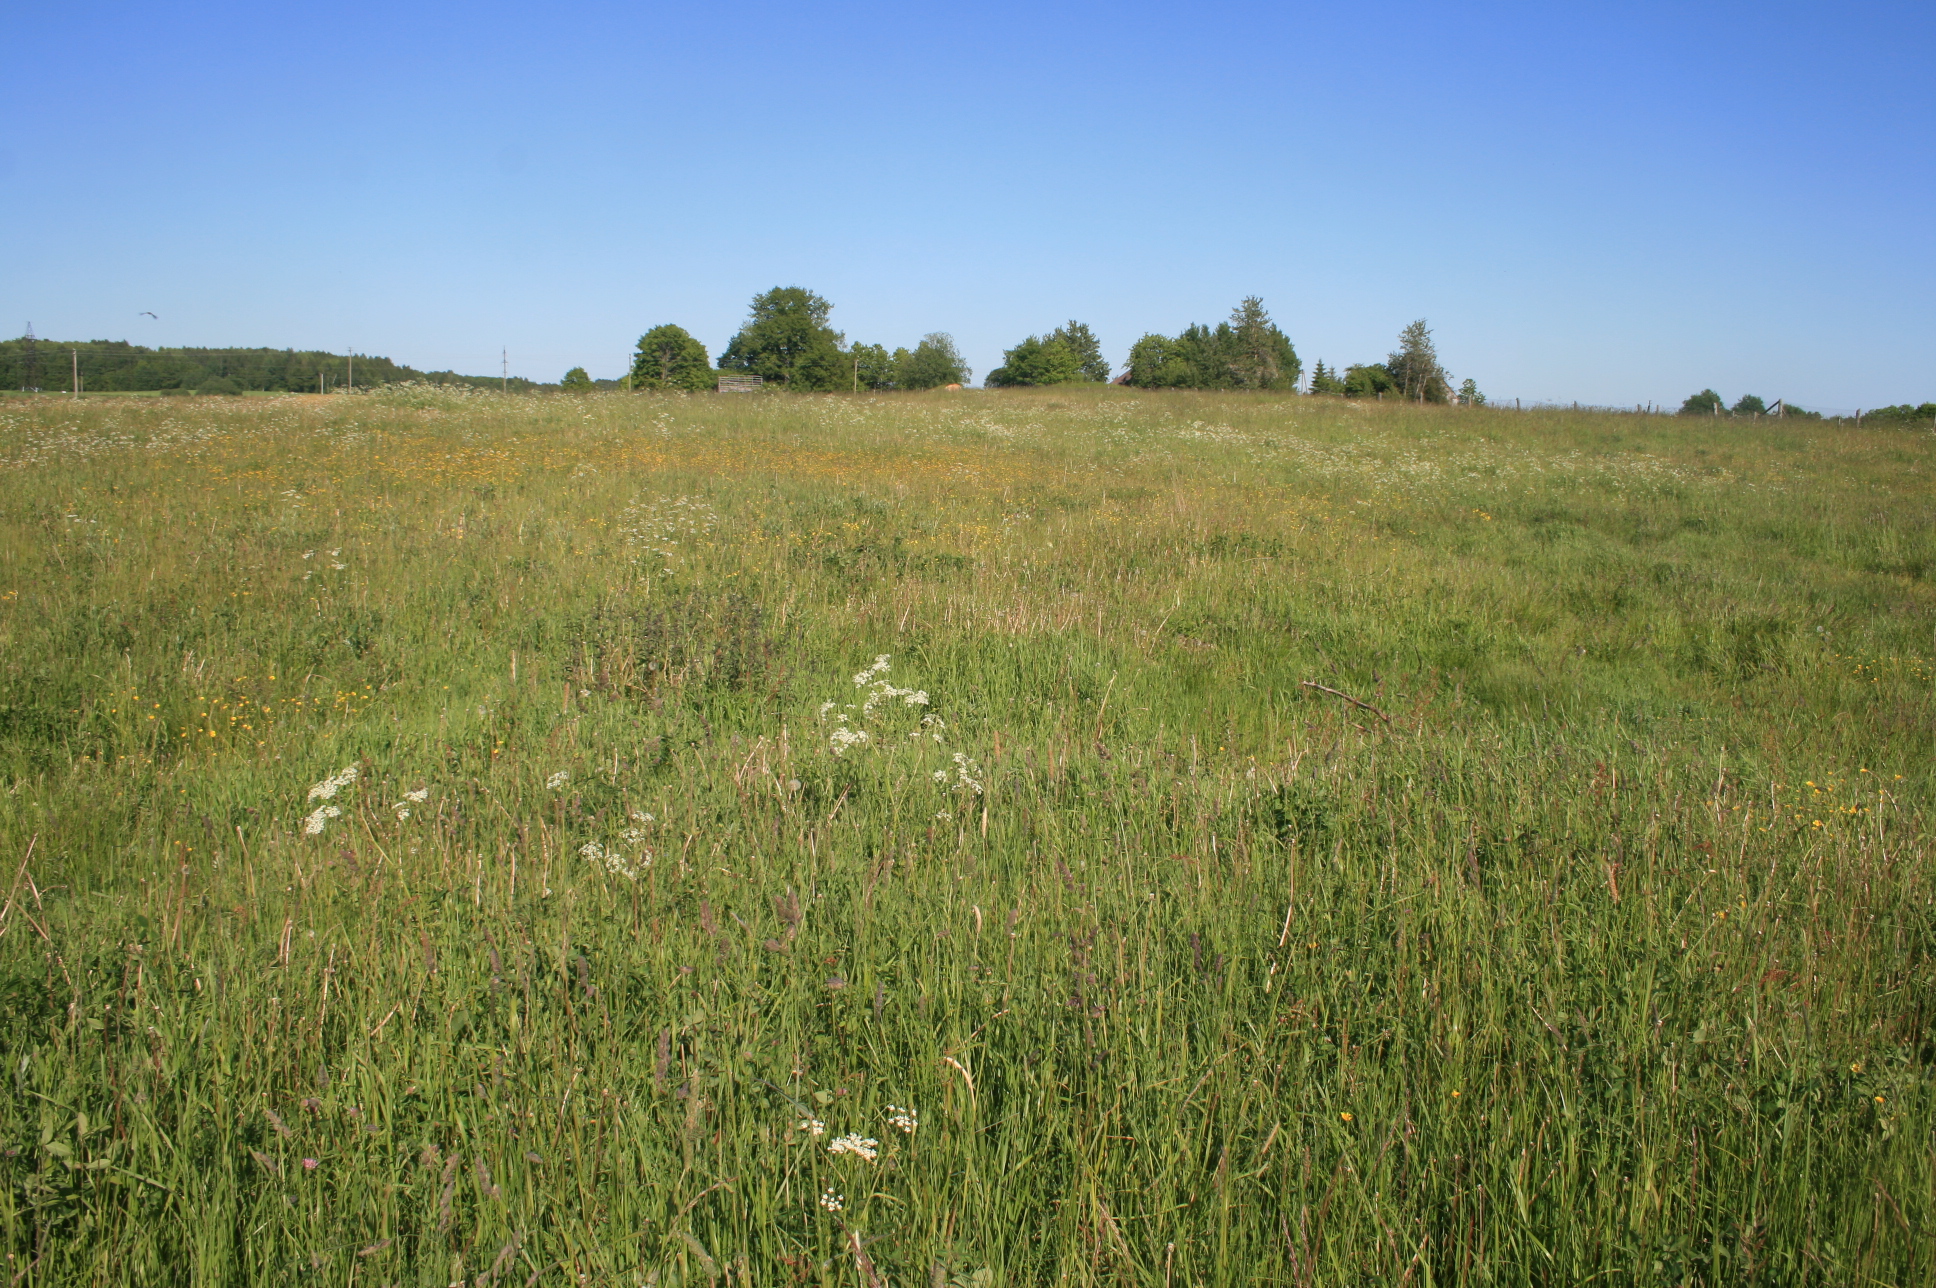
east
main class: Grassland
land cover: Grassland without tree/shrub cover
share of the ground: > 75 %
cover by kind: herbaceous plants 100 %
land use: Agriculture (excluding fallow land and kitchen gardens)
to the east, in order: Grassland without tree/shrub cover; Tracks; Grassland without tree/shrub cover; Single bushes/trees; Grassland without tree/shrub cover; Tracks; Grassland without tree/shrub cover
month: June
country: LT
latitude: 55.5471
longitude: 22.2129
